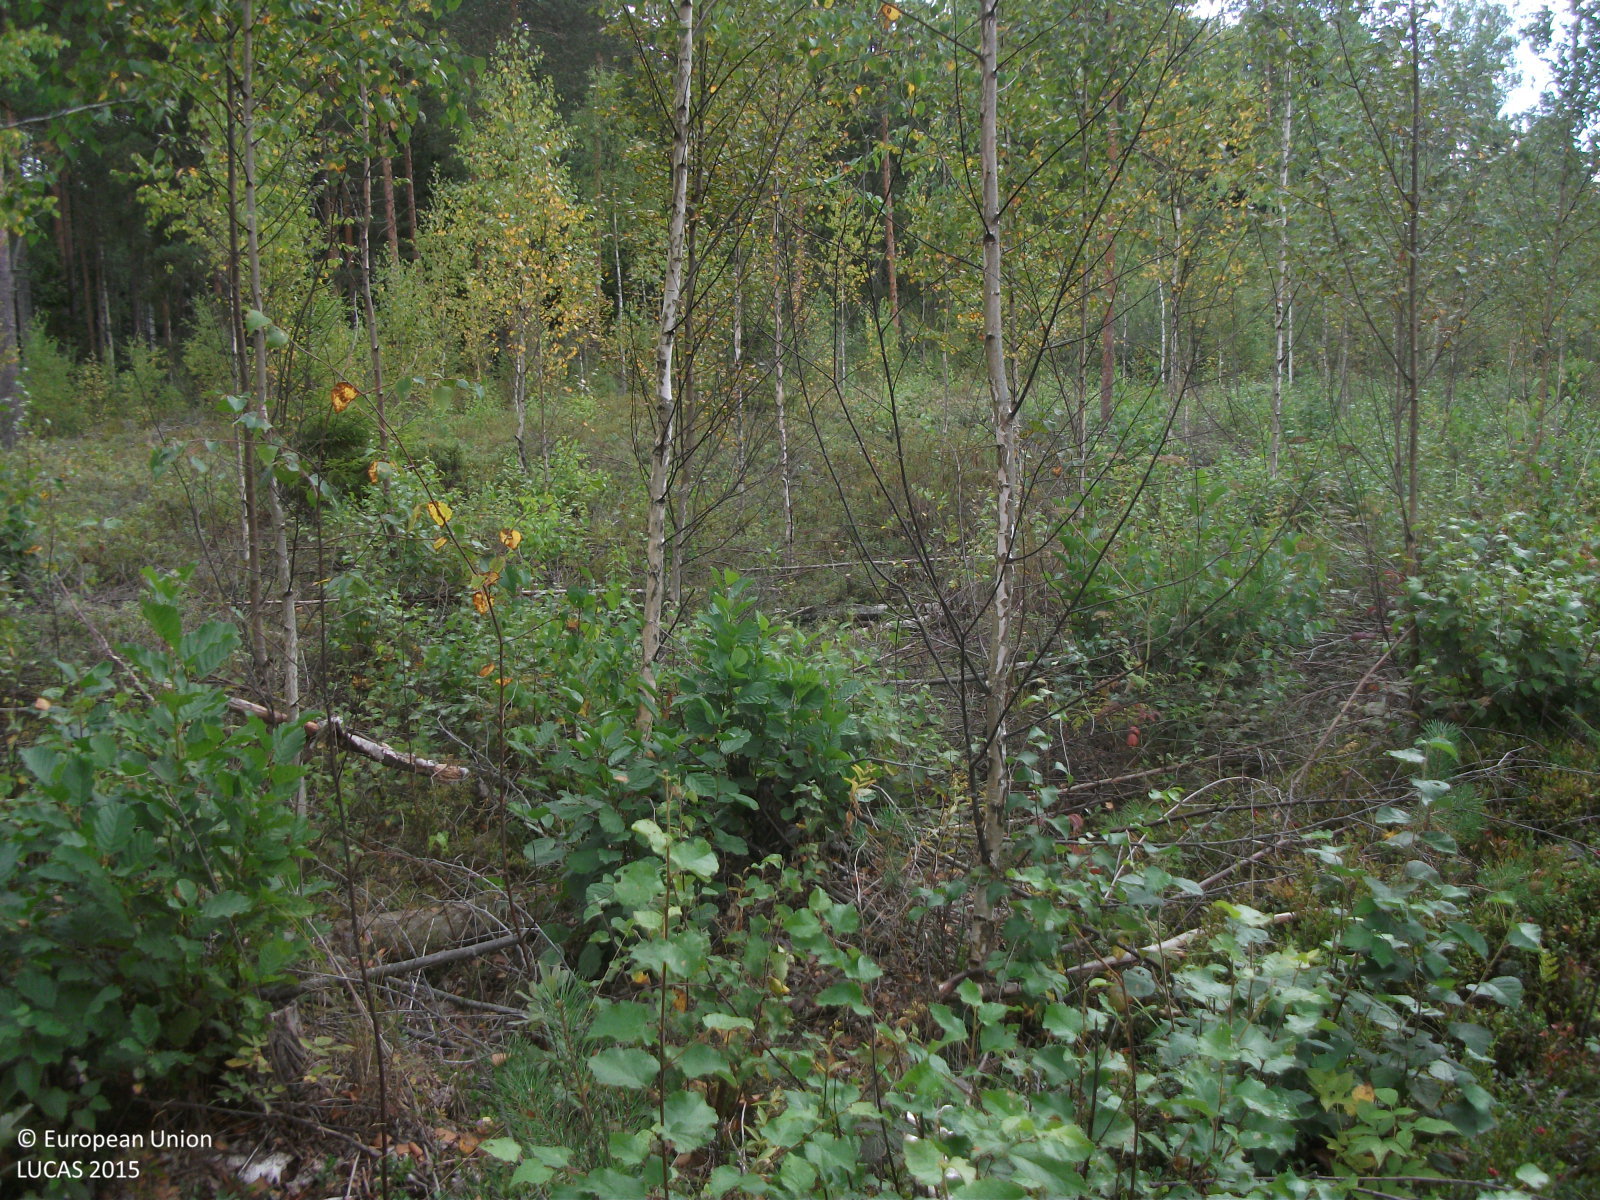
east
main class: Woodland
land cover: Broadleaved woodland
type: non-riverine alder, birch or aspen forest
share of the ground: 50 - 75 %
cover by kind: broadleaved forest trees 60 %, shrubs 20 %, herbaceous plants 10 %, lichens and mosses 10 %
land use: Forestry
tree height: < 5 m
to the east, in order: Broadleaved woodland; Ditches and canals; Pine dominated coniferous woodland; Ditches and canals; Shrubland with sparse tree cover; Ditches and canals; Pine dominated mixed woodland; Other mixed woodland
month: September
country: LV
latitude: 56.5639
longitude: 26.2001
